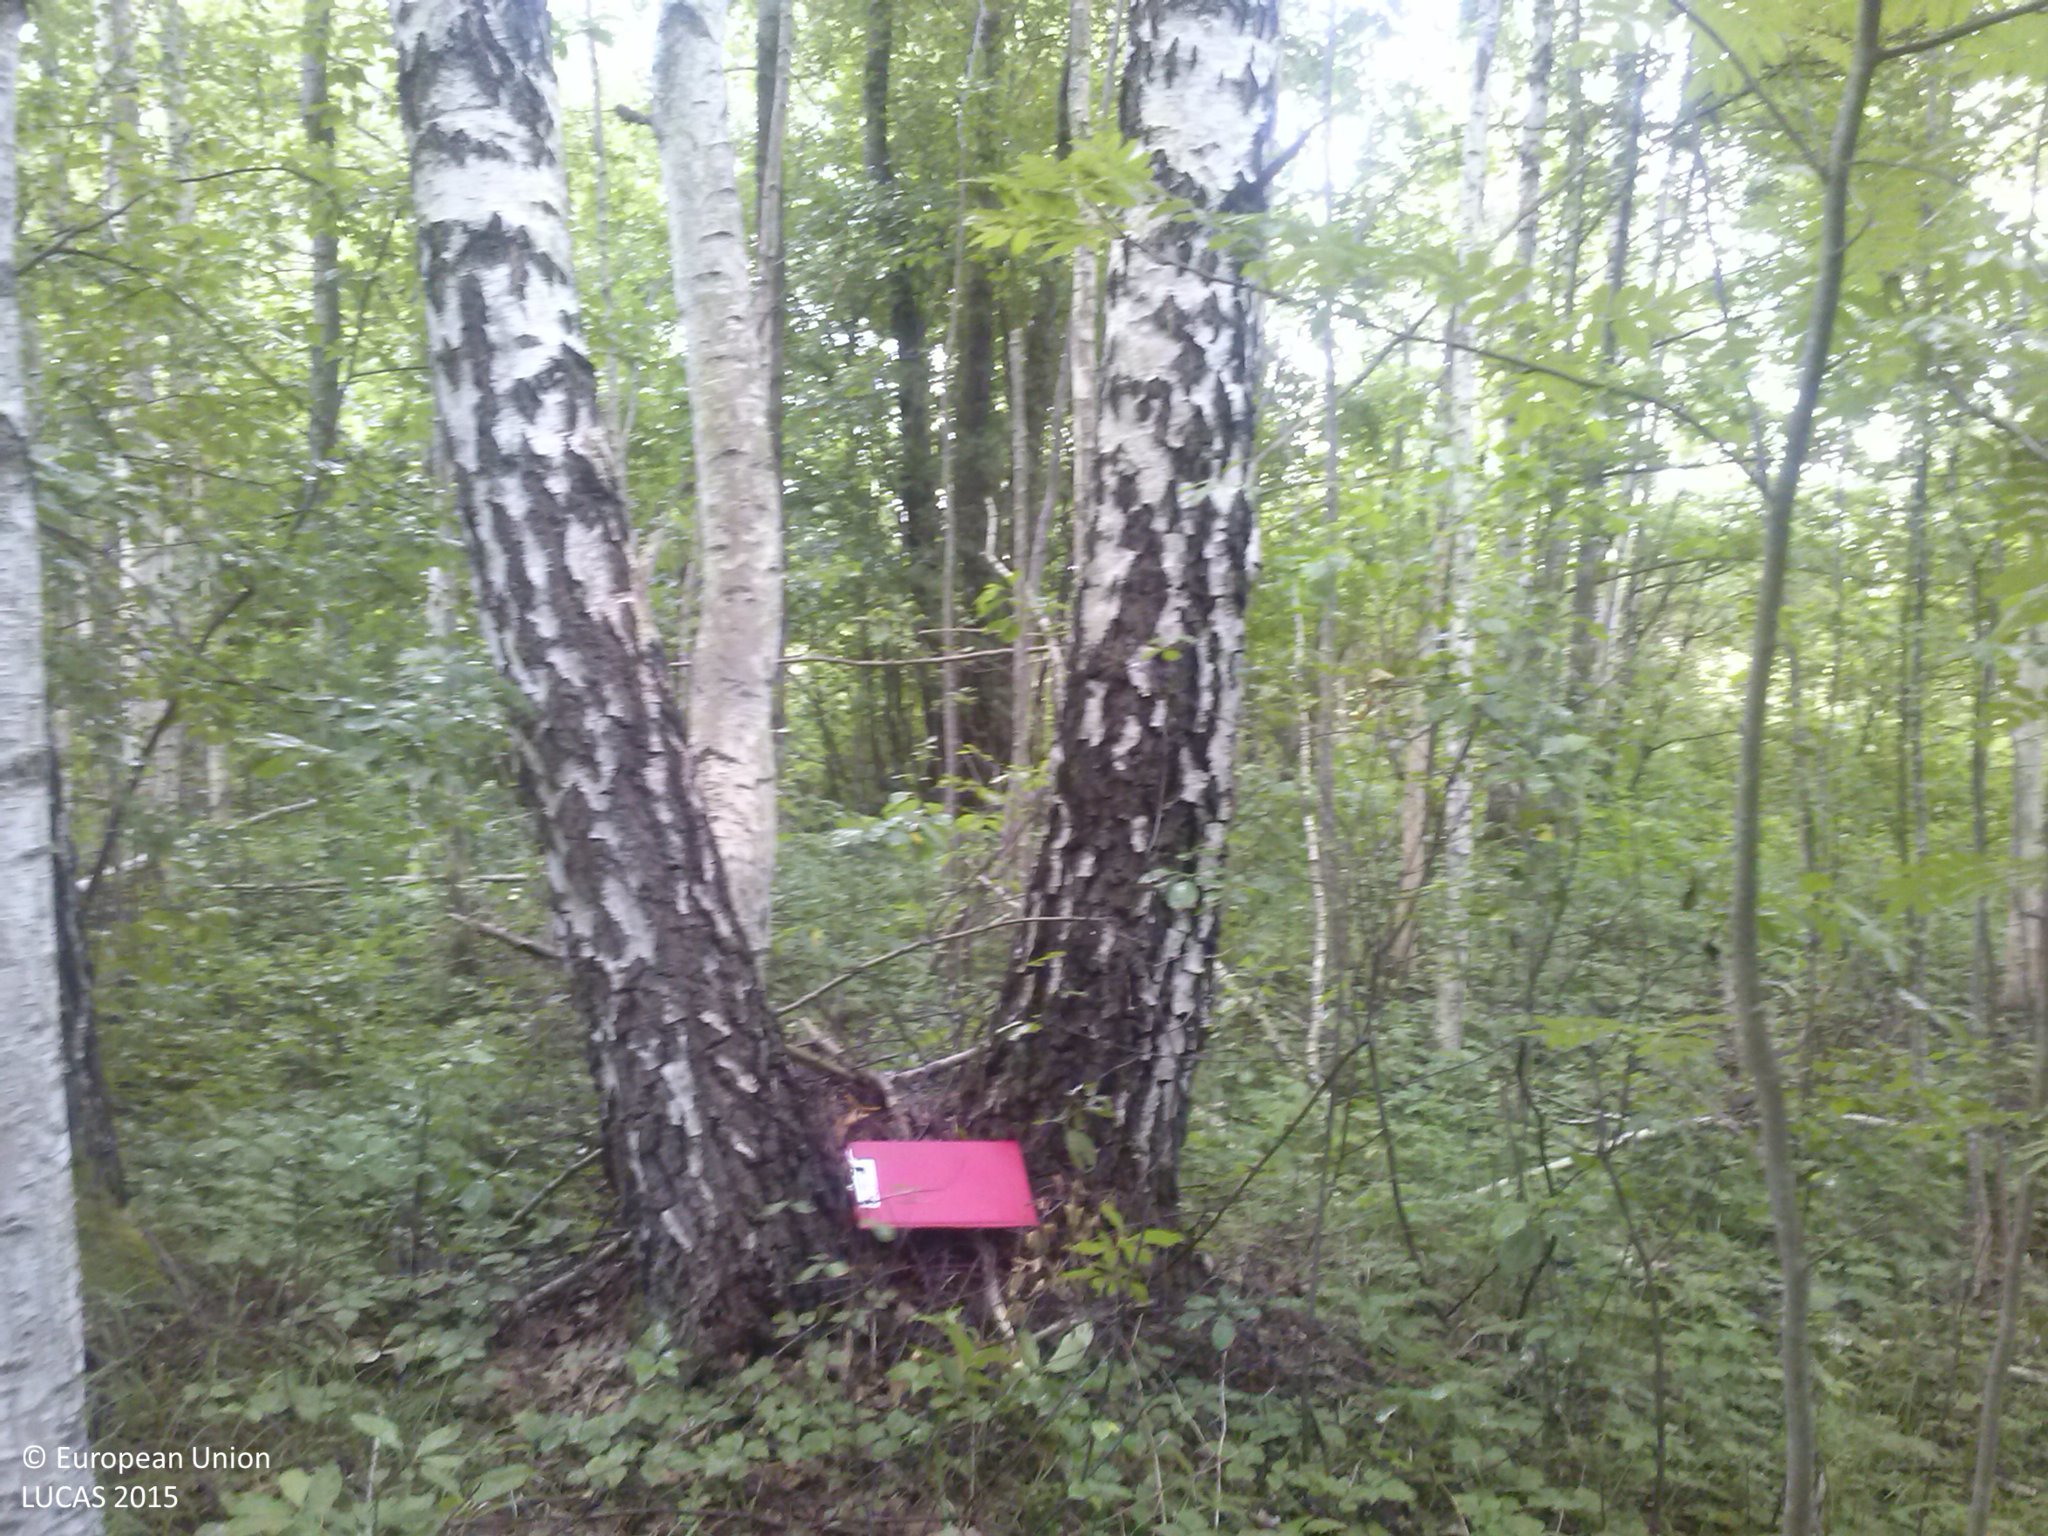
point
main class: Woodland
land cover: Broadleaved woodland
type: non-riverine alder, birch or aspen forest
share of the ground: > 75 %
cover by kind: broadleaved forest trees 75 %, herbaceous plants 25 %
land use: Forestry
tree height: > 5 m
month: July
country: LV
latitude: 56.6959
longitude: 27.5718
